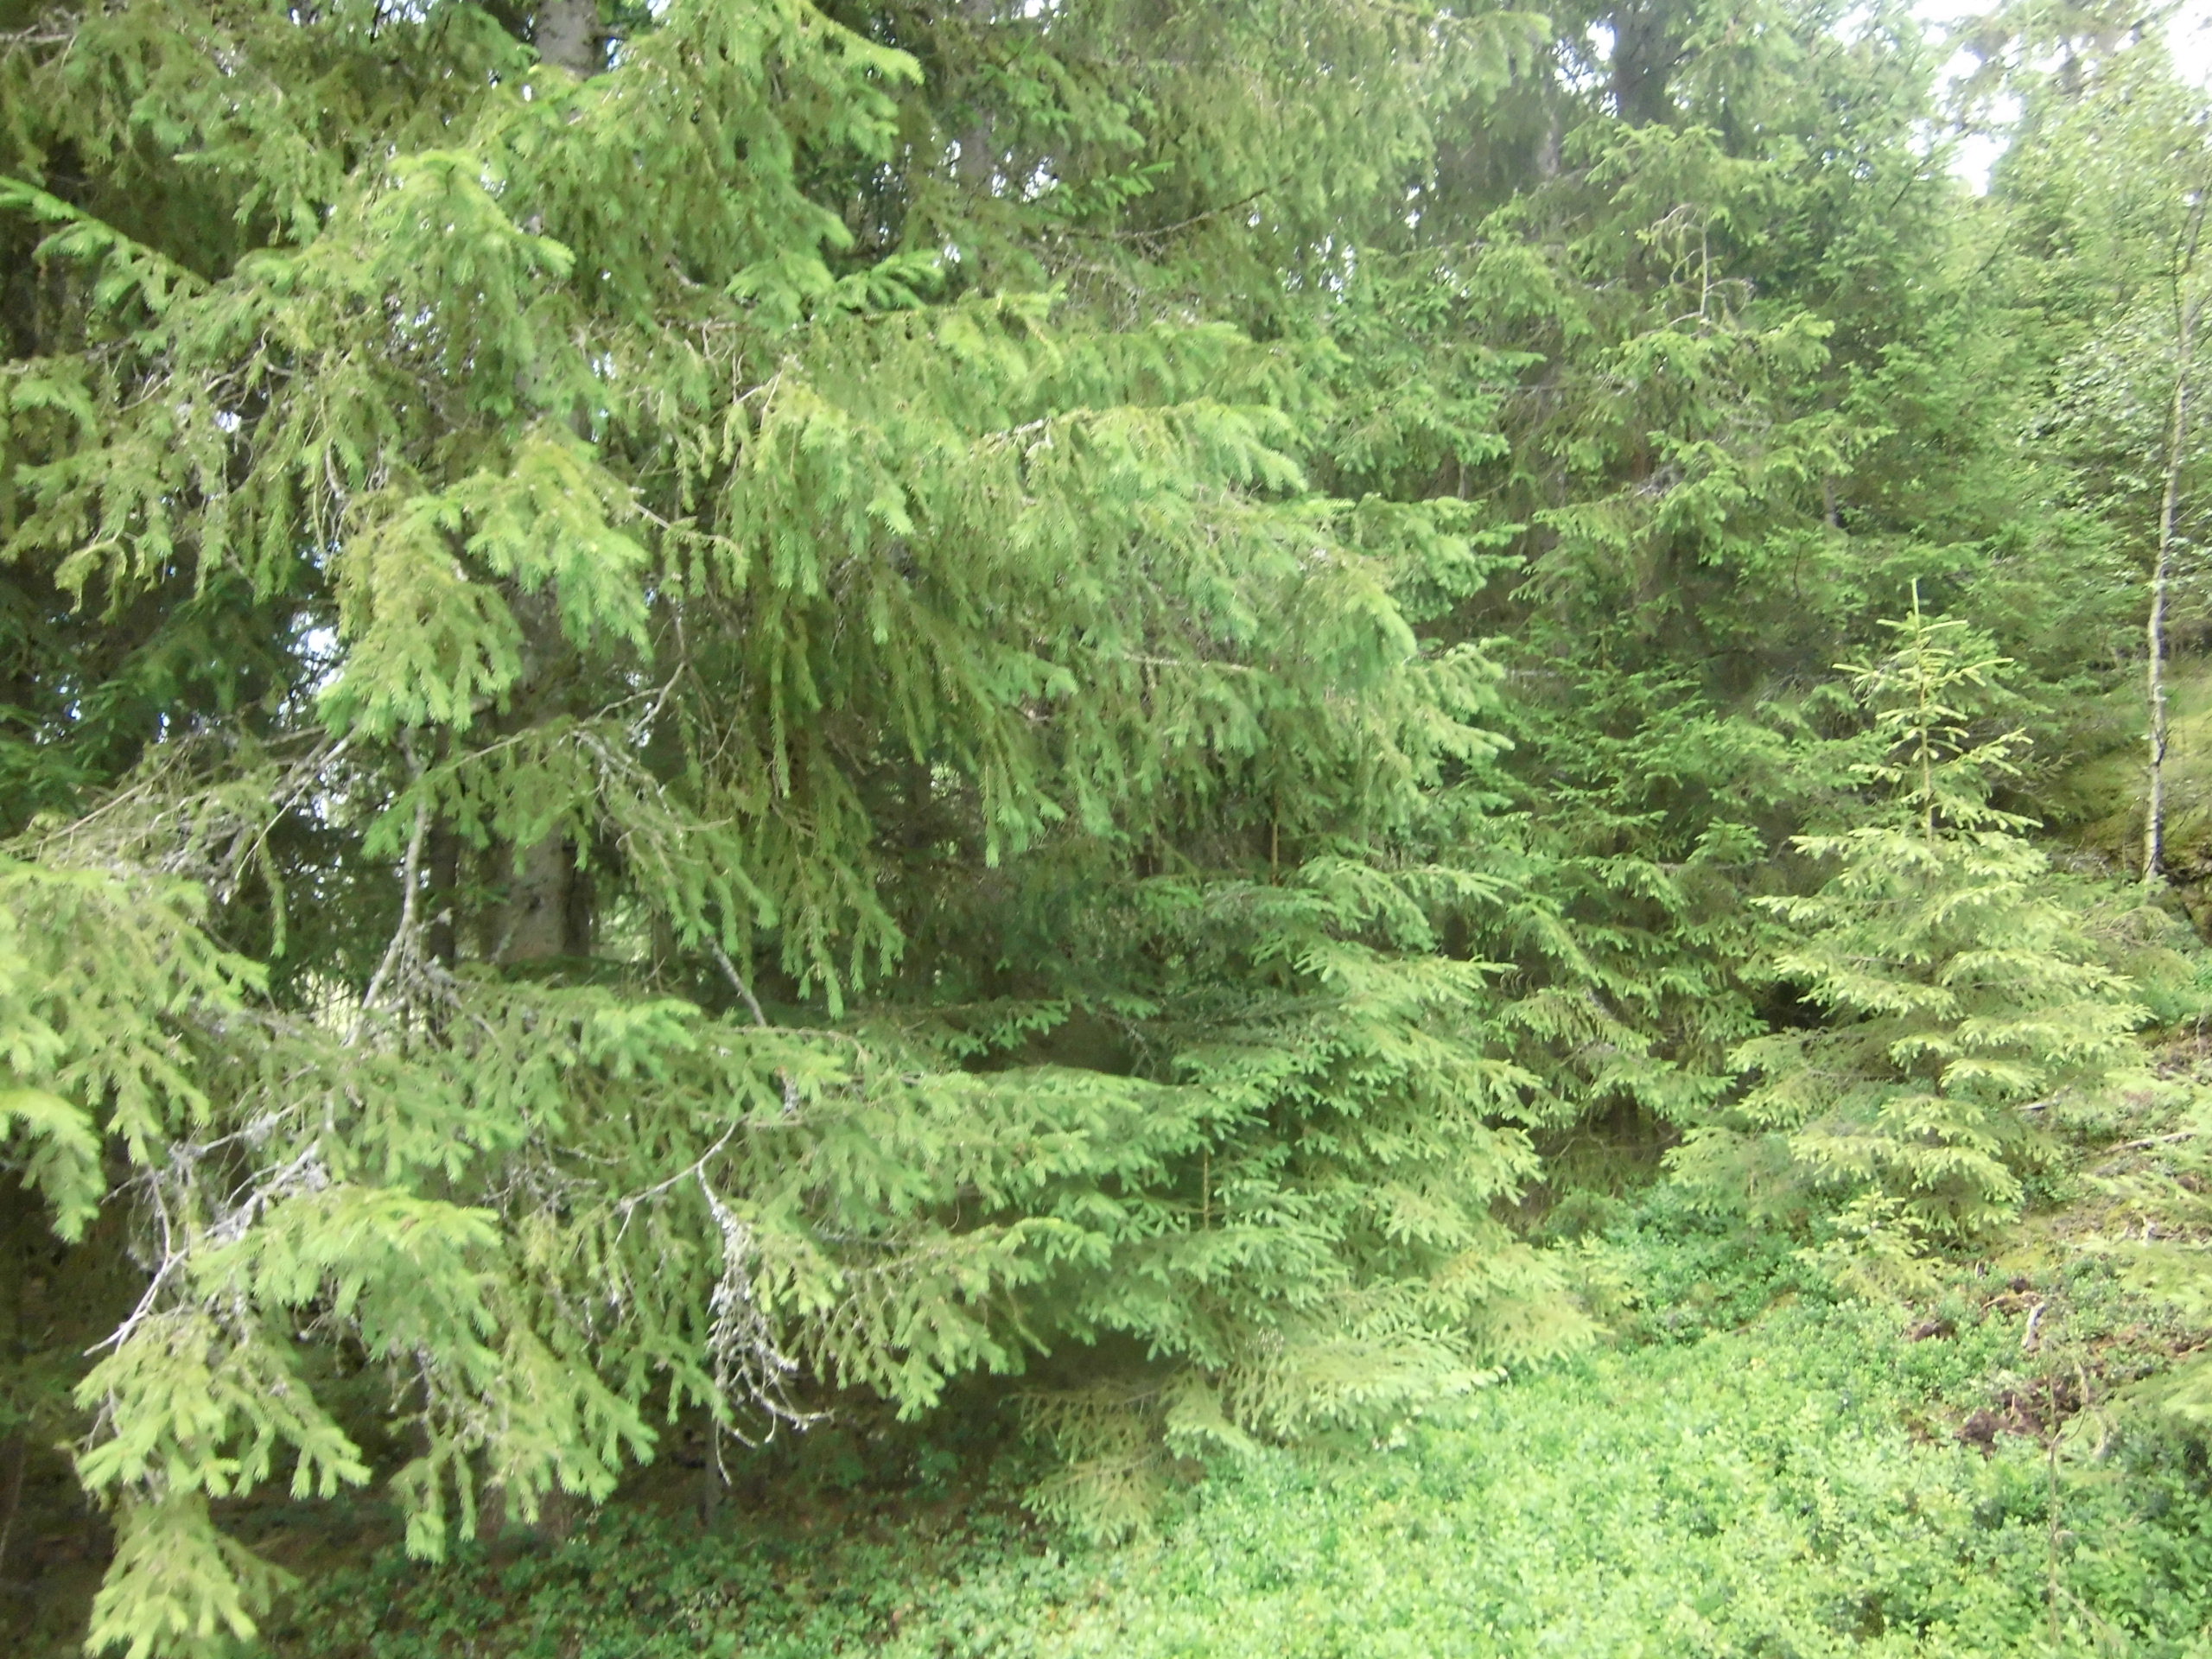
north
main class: Woodland
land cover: Spruce dominated mixed woodland
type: boreal forest
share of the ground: 50 - 75 %
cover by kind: coniferous forest trees 30 %, shrubs 25 %, broadleaved forest trees 20 %, lichens and mosses 15 %, herbaceous plants 10 %
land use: Forestry
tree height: > 5 m
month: July
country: SE
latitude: 57.2723
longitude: 15.1876
